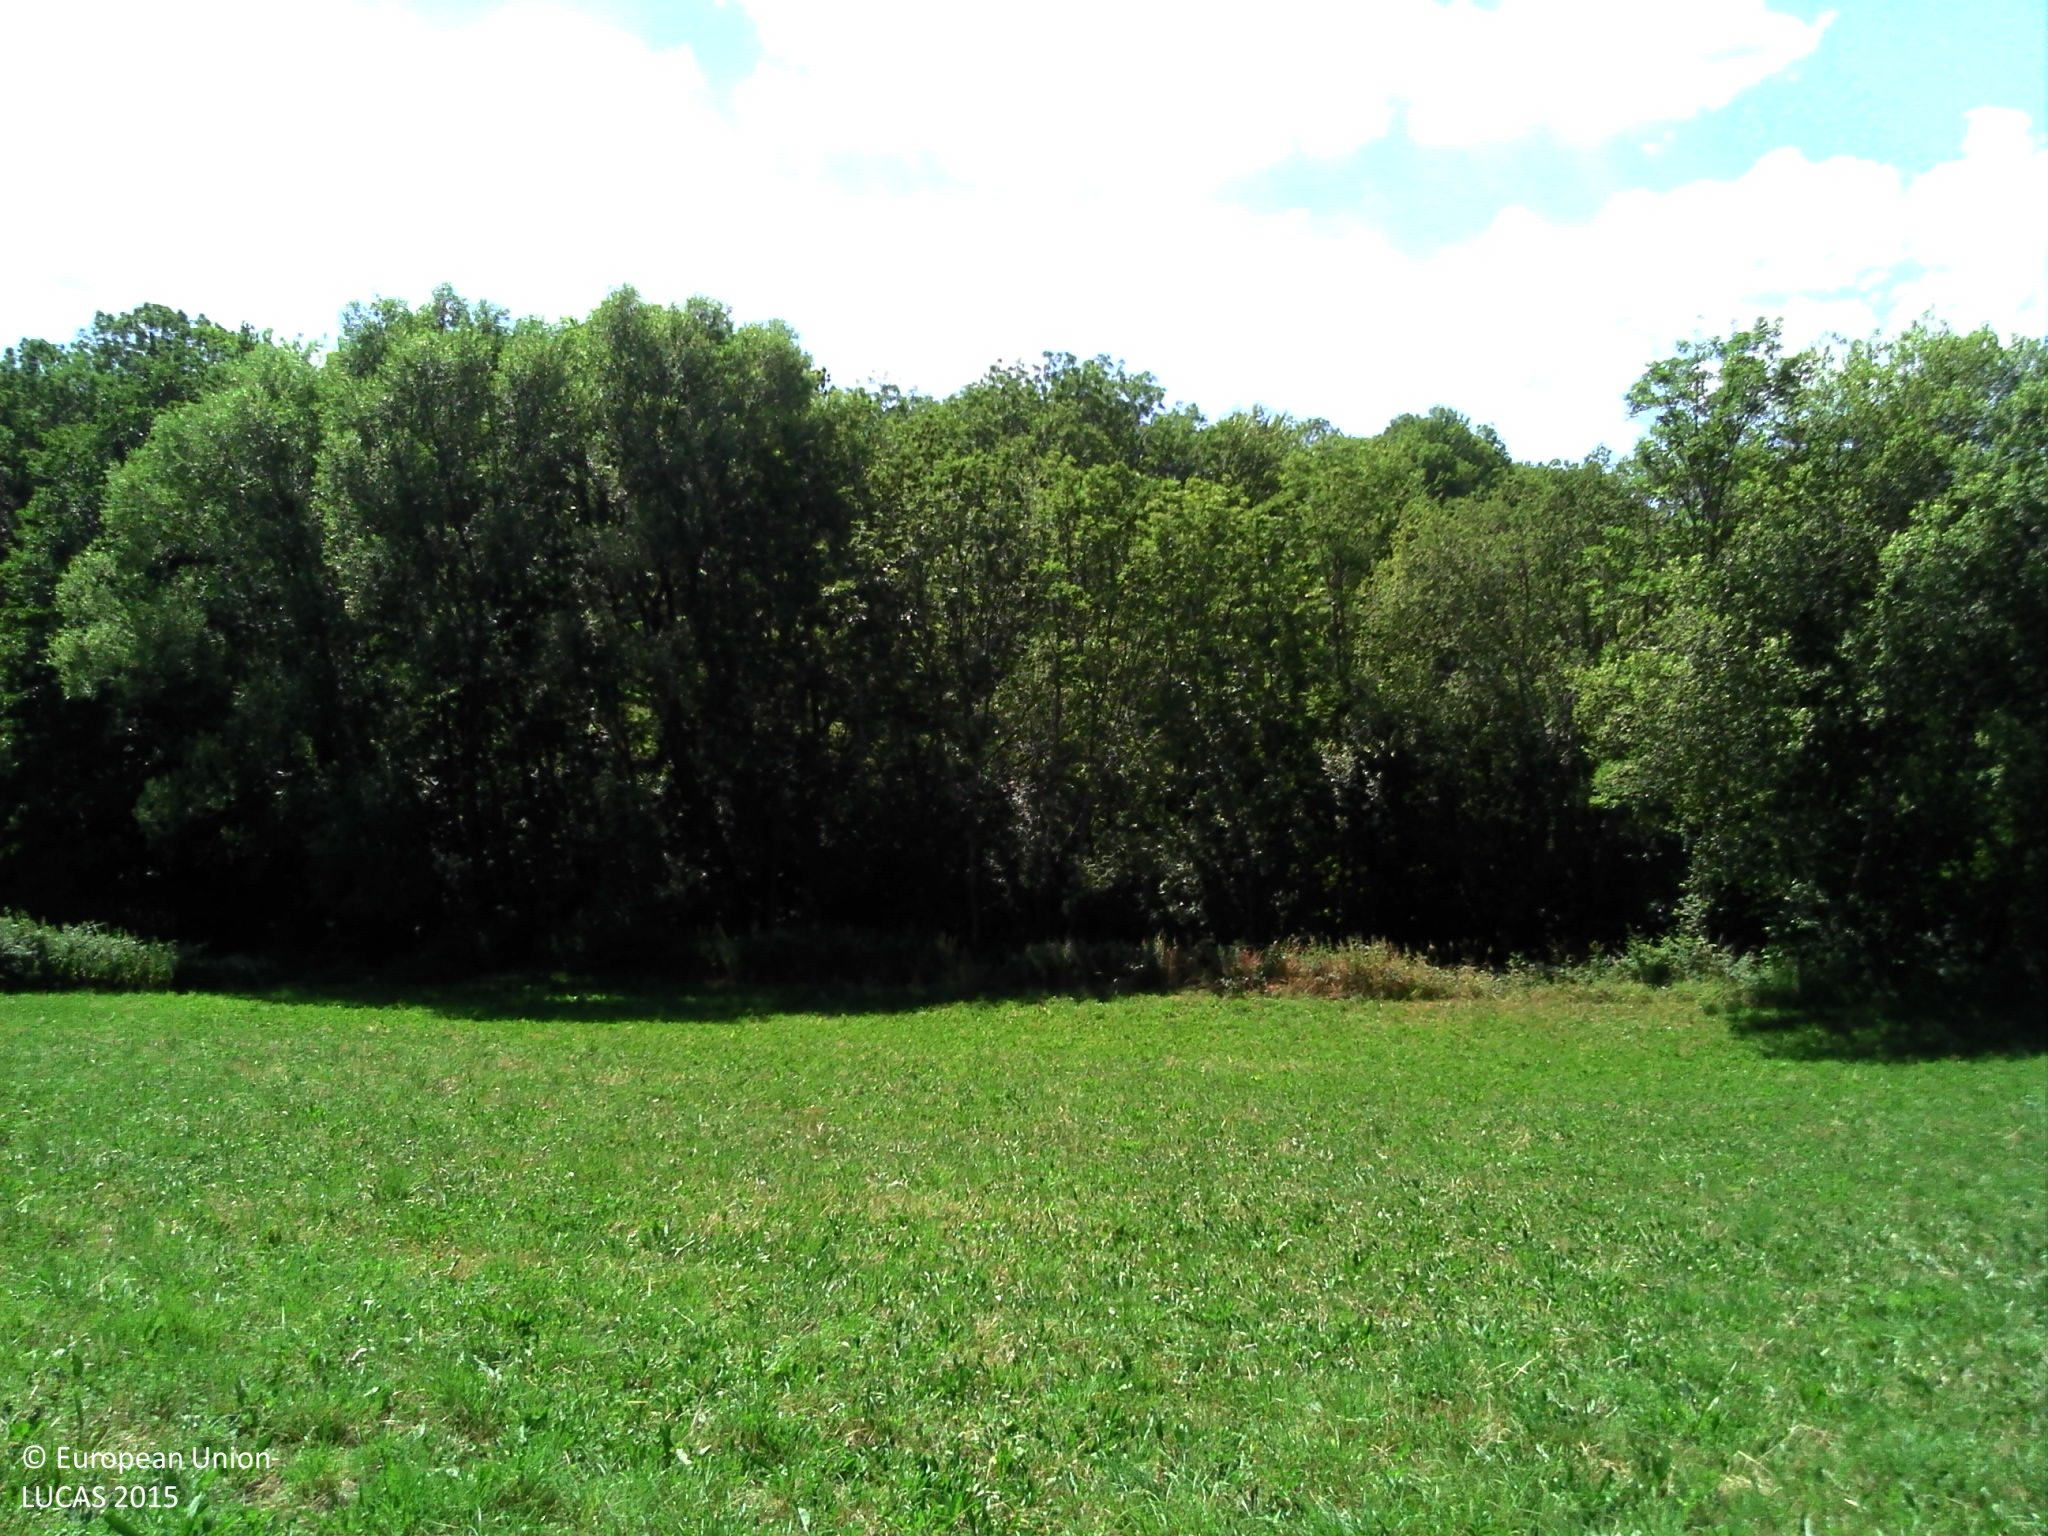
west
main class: Grassland
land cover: Grassland without tree/shrub cover
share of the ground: > 75 %
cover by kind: herbaceous plants 100 %
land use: Agriculture (excluding fallow land and kitchen gardens)
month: June
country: FR
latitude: 45.5299
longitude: 3.0733
